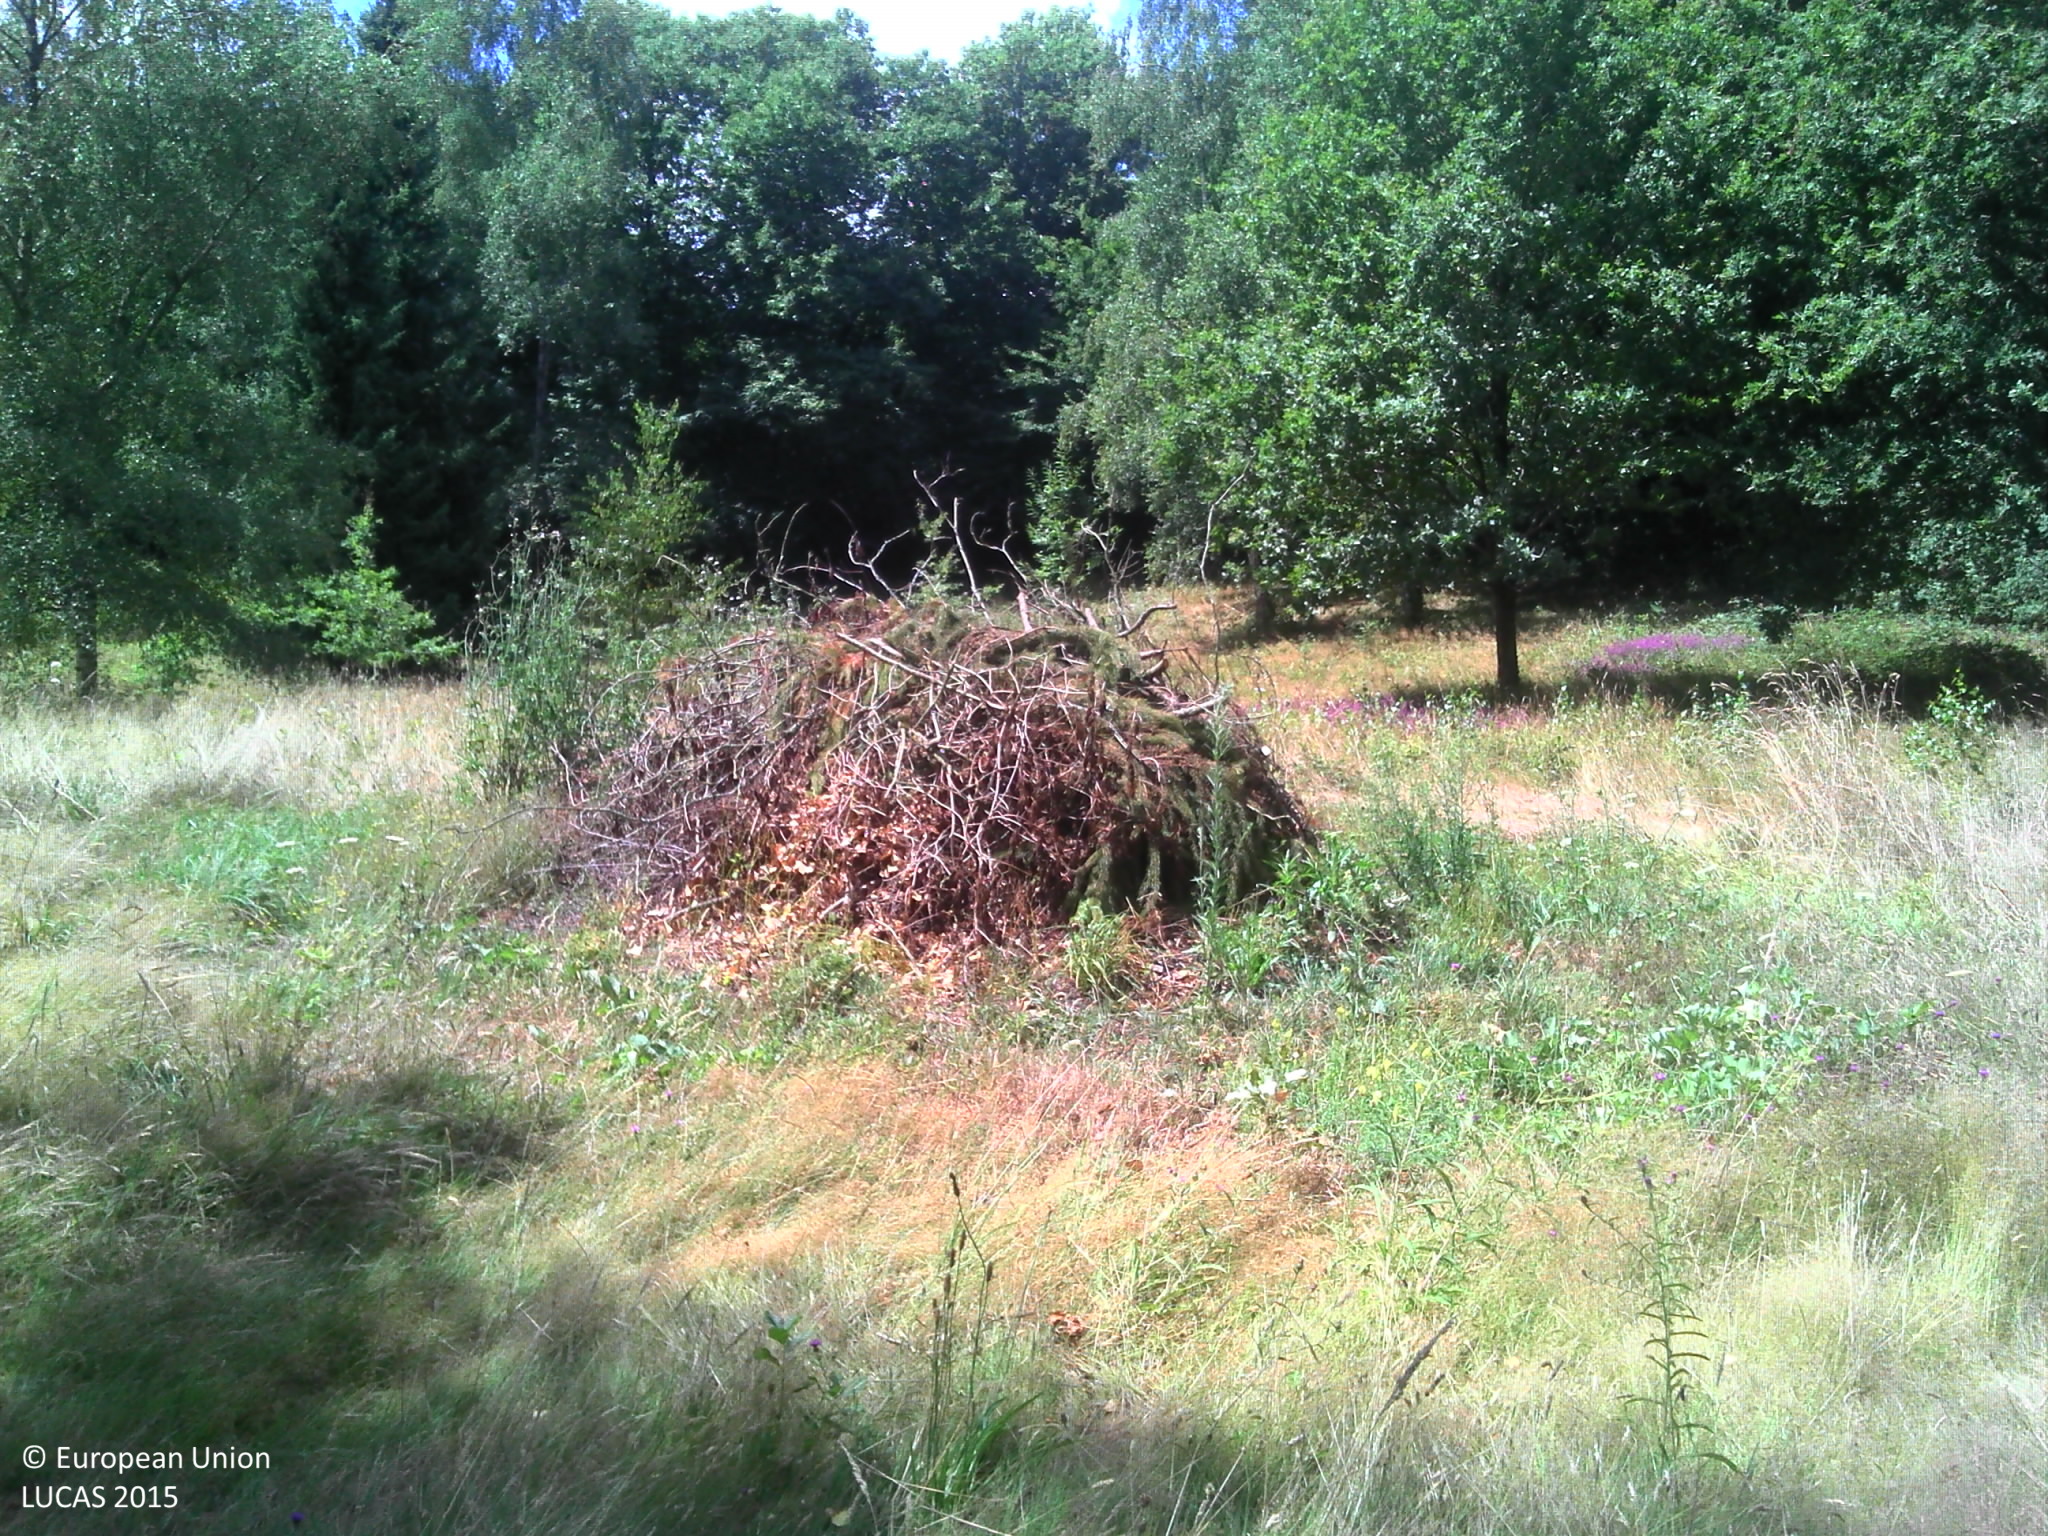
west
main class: Grassland
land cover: Grassland with sparse tree/shrub cover
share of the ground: > 75 %
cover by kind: herbaceous plants 85 %, shrubs 10 %, broadleaved forest trees 5 %
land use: Residential
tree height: > 5 m
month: August
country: FR
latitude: 46.7233
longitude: -1.3812
